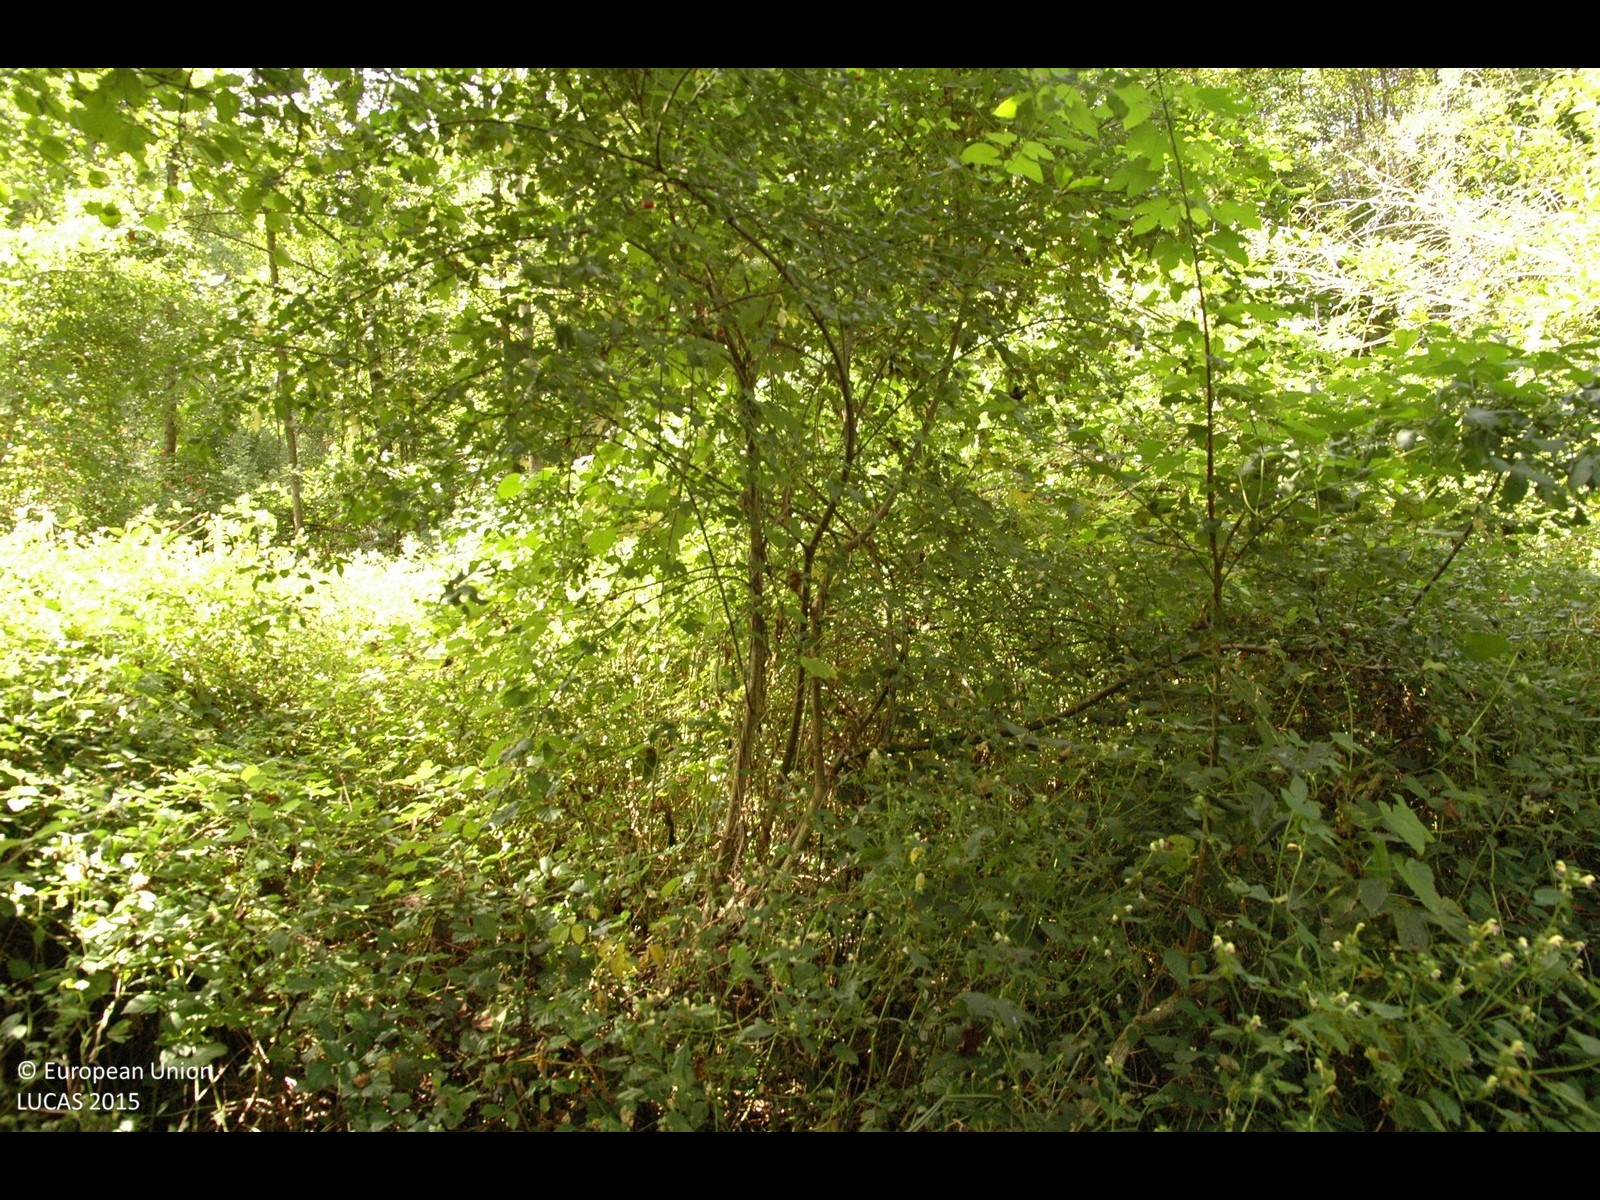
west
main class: Woodland
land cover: Broadleaved woodland
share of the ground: > 75 %
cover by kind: broadleaved forest trees 100 %
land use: Forestry
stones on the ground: < 10 %
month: September
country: HR
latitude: 45.5711
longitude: 15.9556
